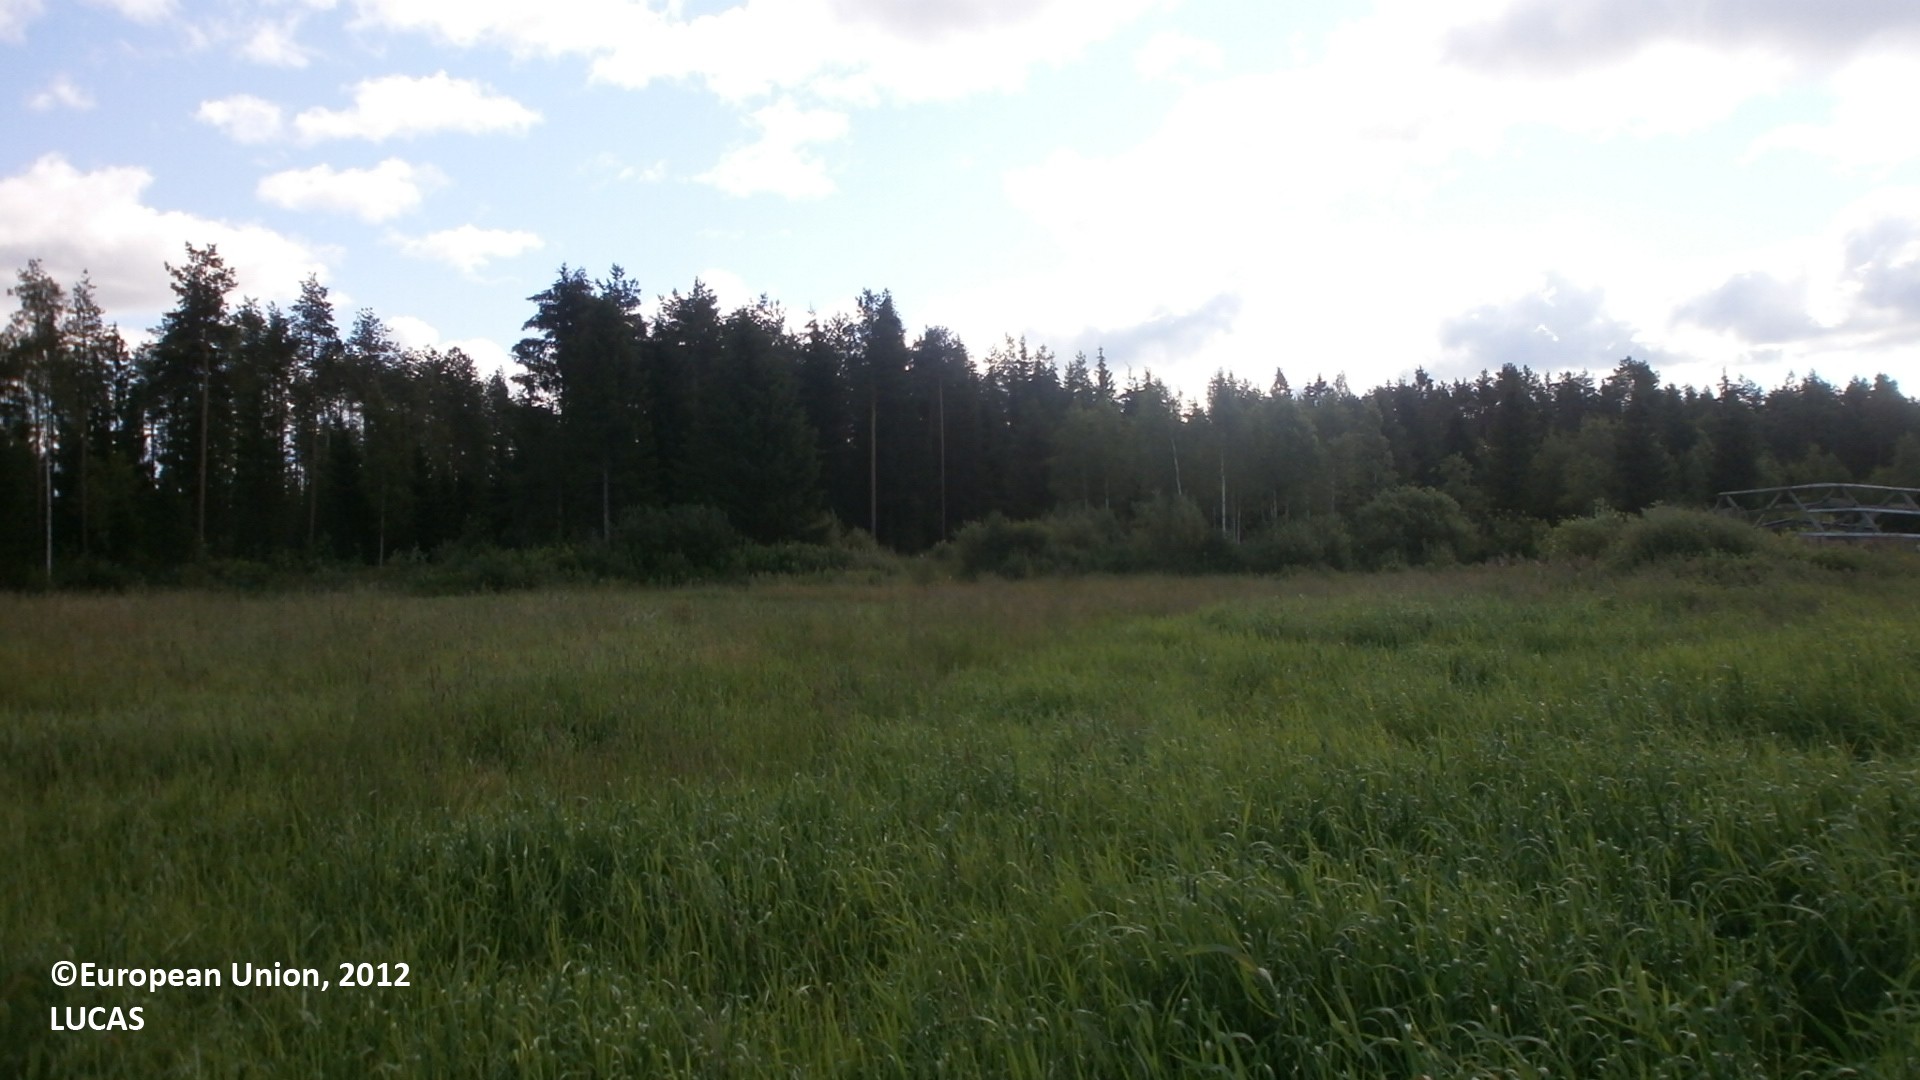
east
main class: Cropland
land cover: Temporary grasslands
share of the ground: > 75 %
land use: Agriculture (excluding fallow land and kitchen gardens)
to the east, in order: Temporary grasslands; Grassland with sparse tree/shrub cover; Spruce dominated coniferous woodland; Ditches and canals; Spruce dominated coniferous woodland; Pine dominated coniferous woodland
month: July
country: FI
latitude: 64.0904
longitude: 24.1591
